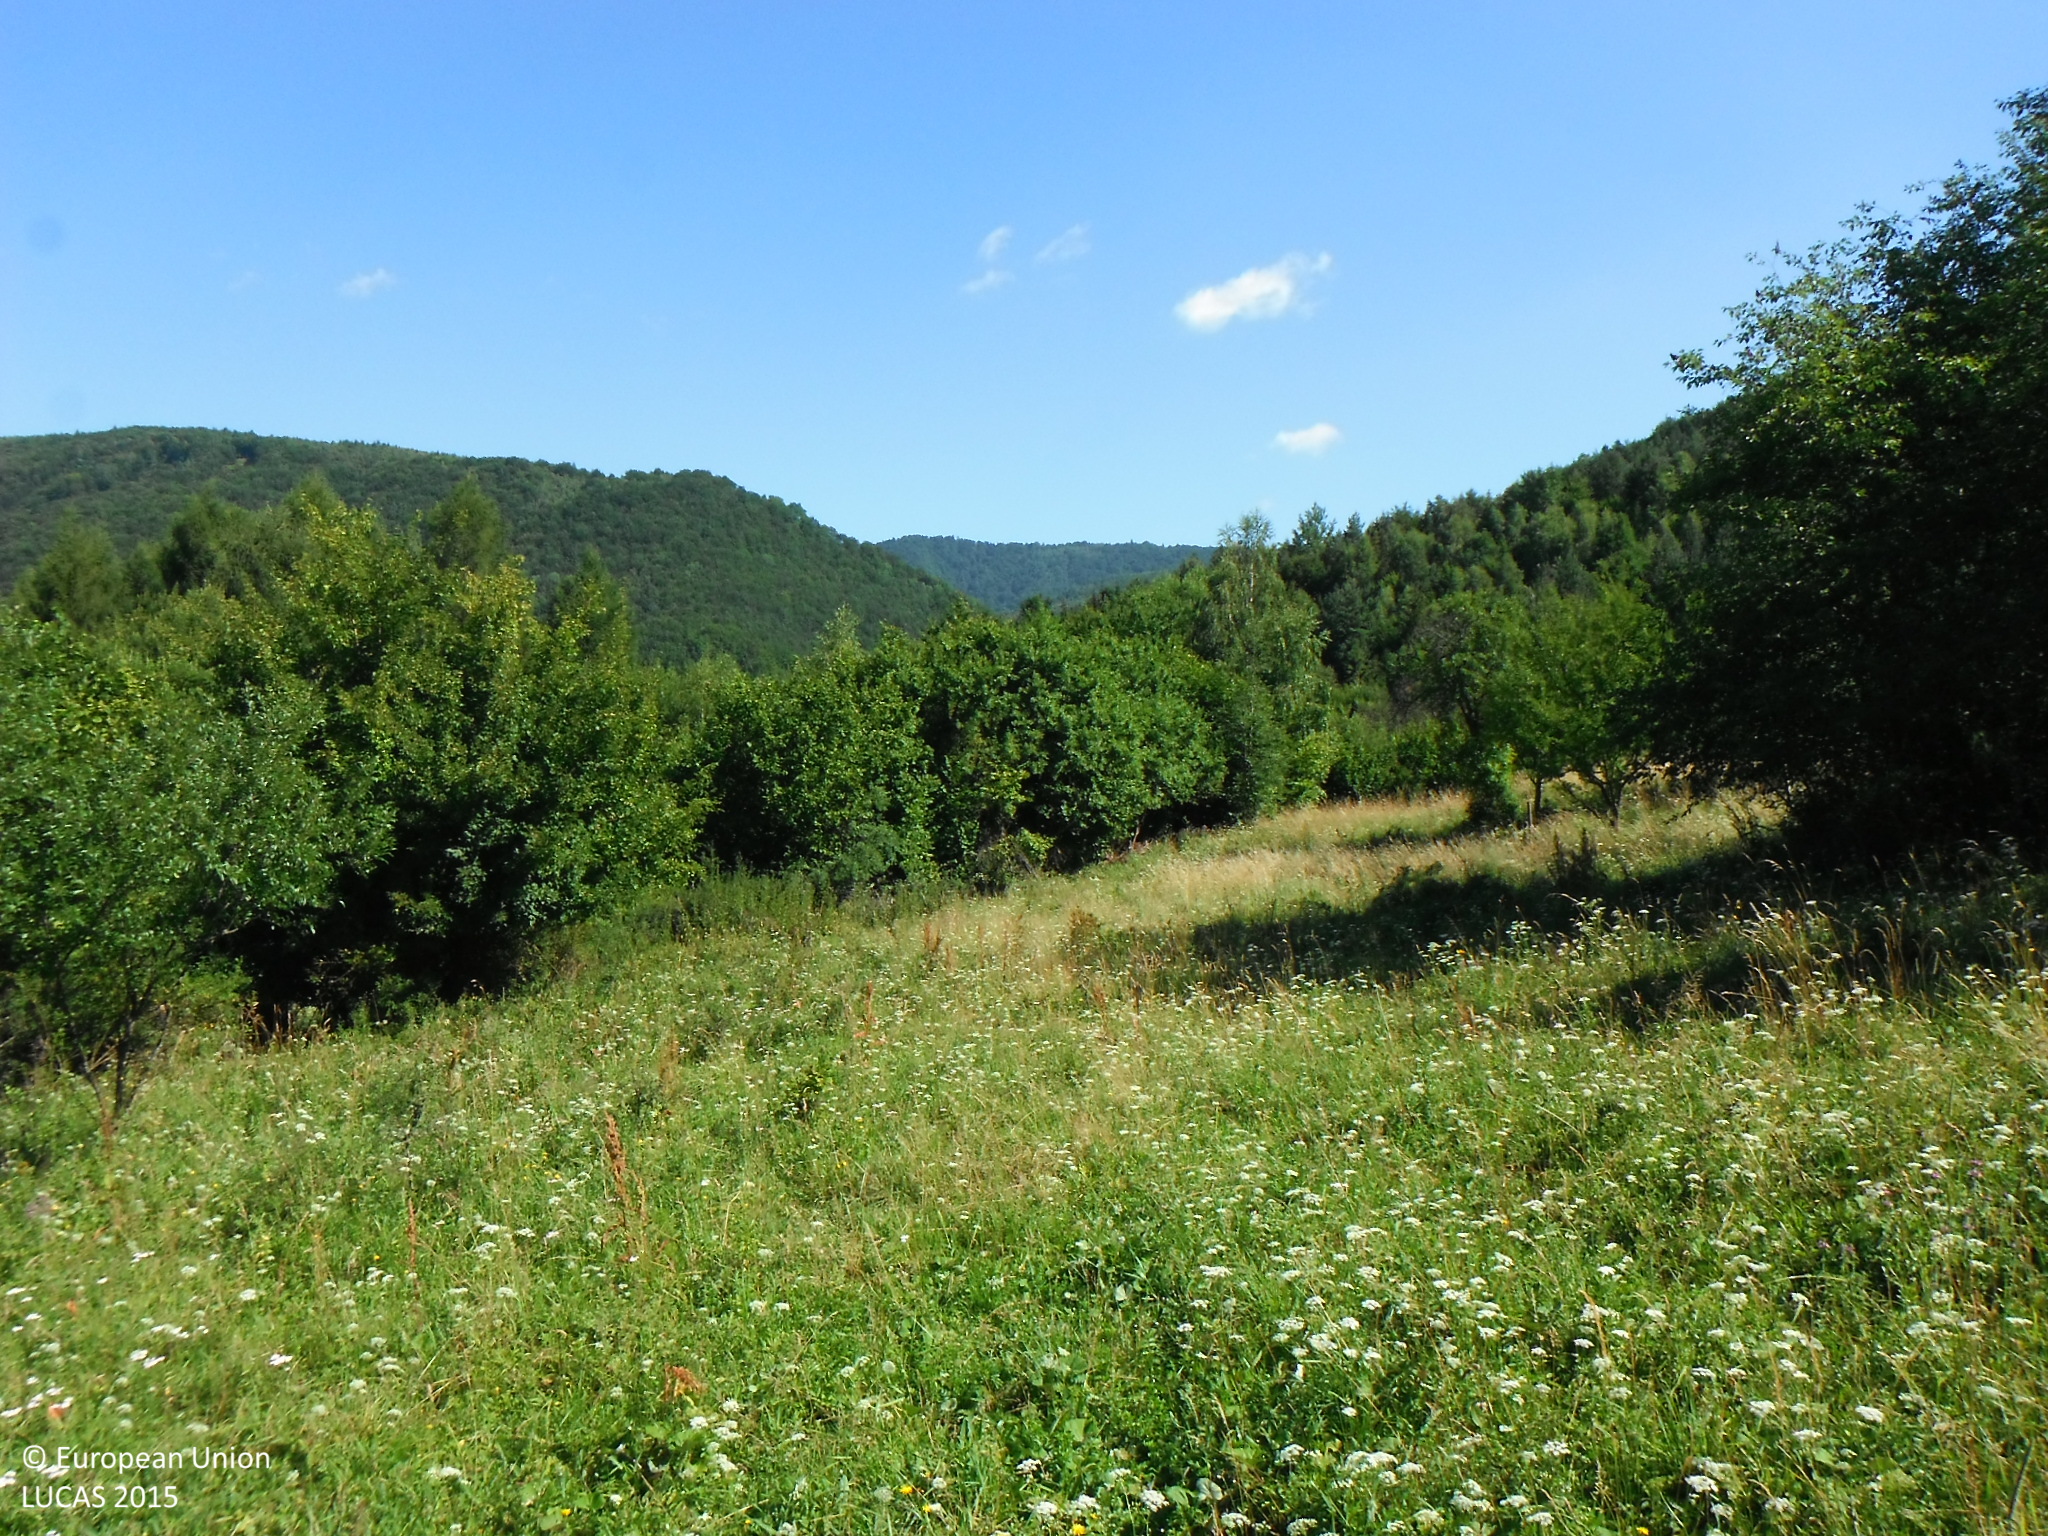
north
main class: Grassland
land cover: Spontaneously vegetated surfaces
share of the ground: > 75 %
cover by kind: herbaceous plants 95 %, shrubs 5 %
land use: Semi-natural and natural areas not in use
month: July
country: SK
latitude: 49.1726
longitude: 21.0573
